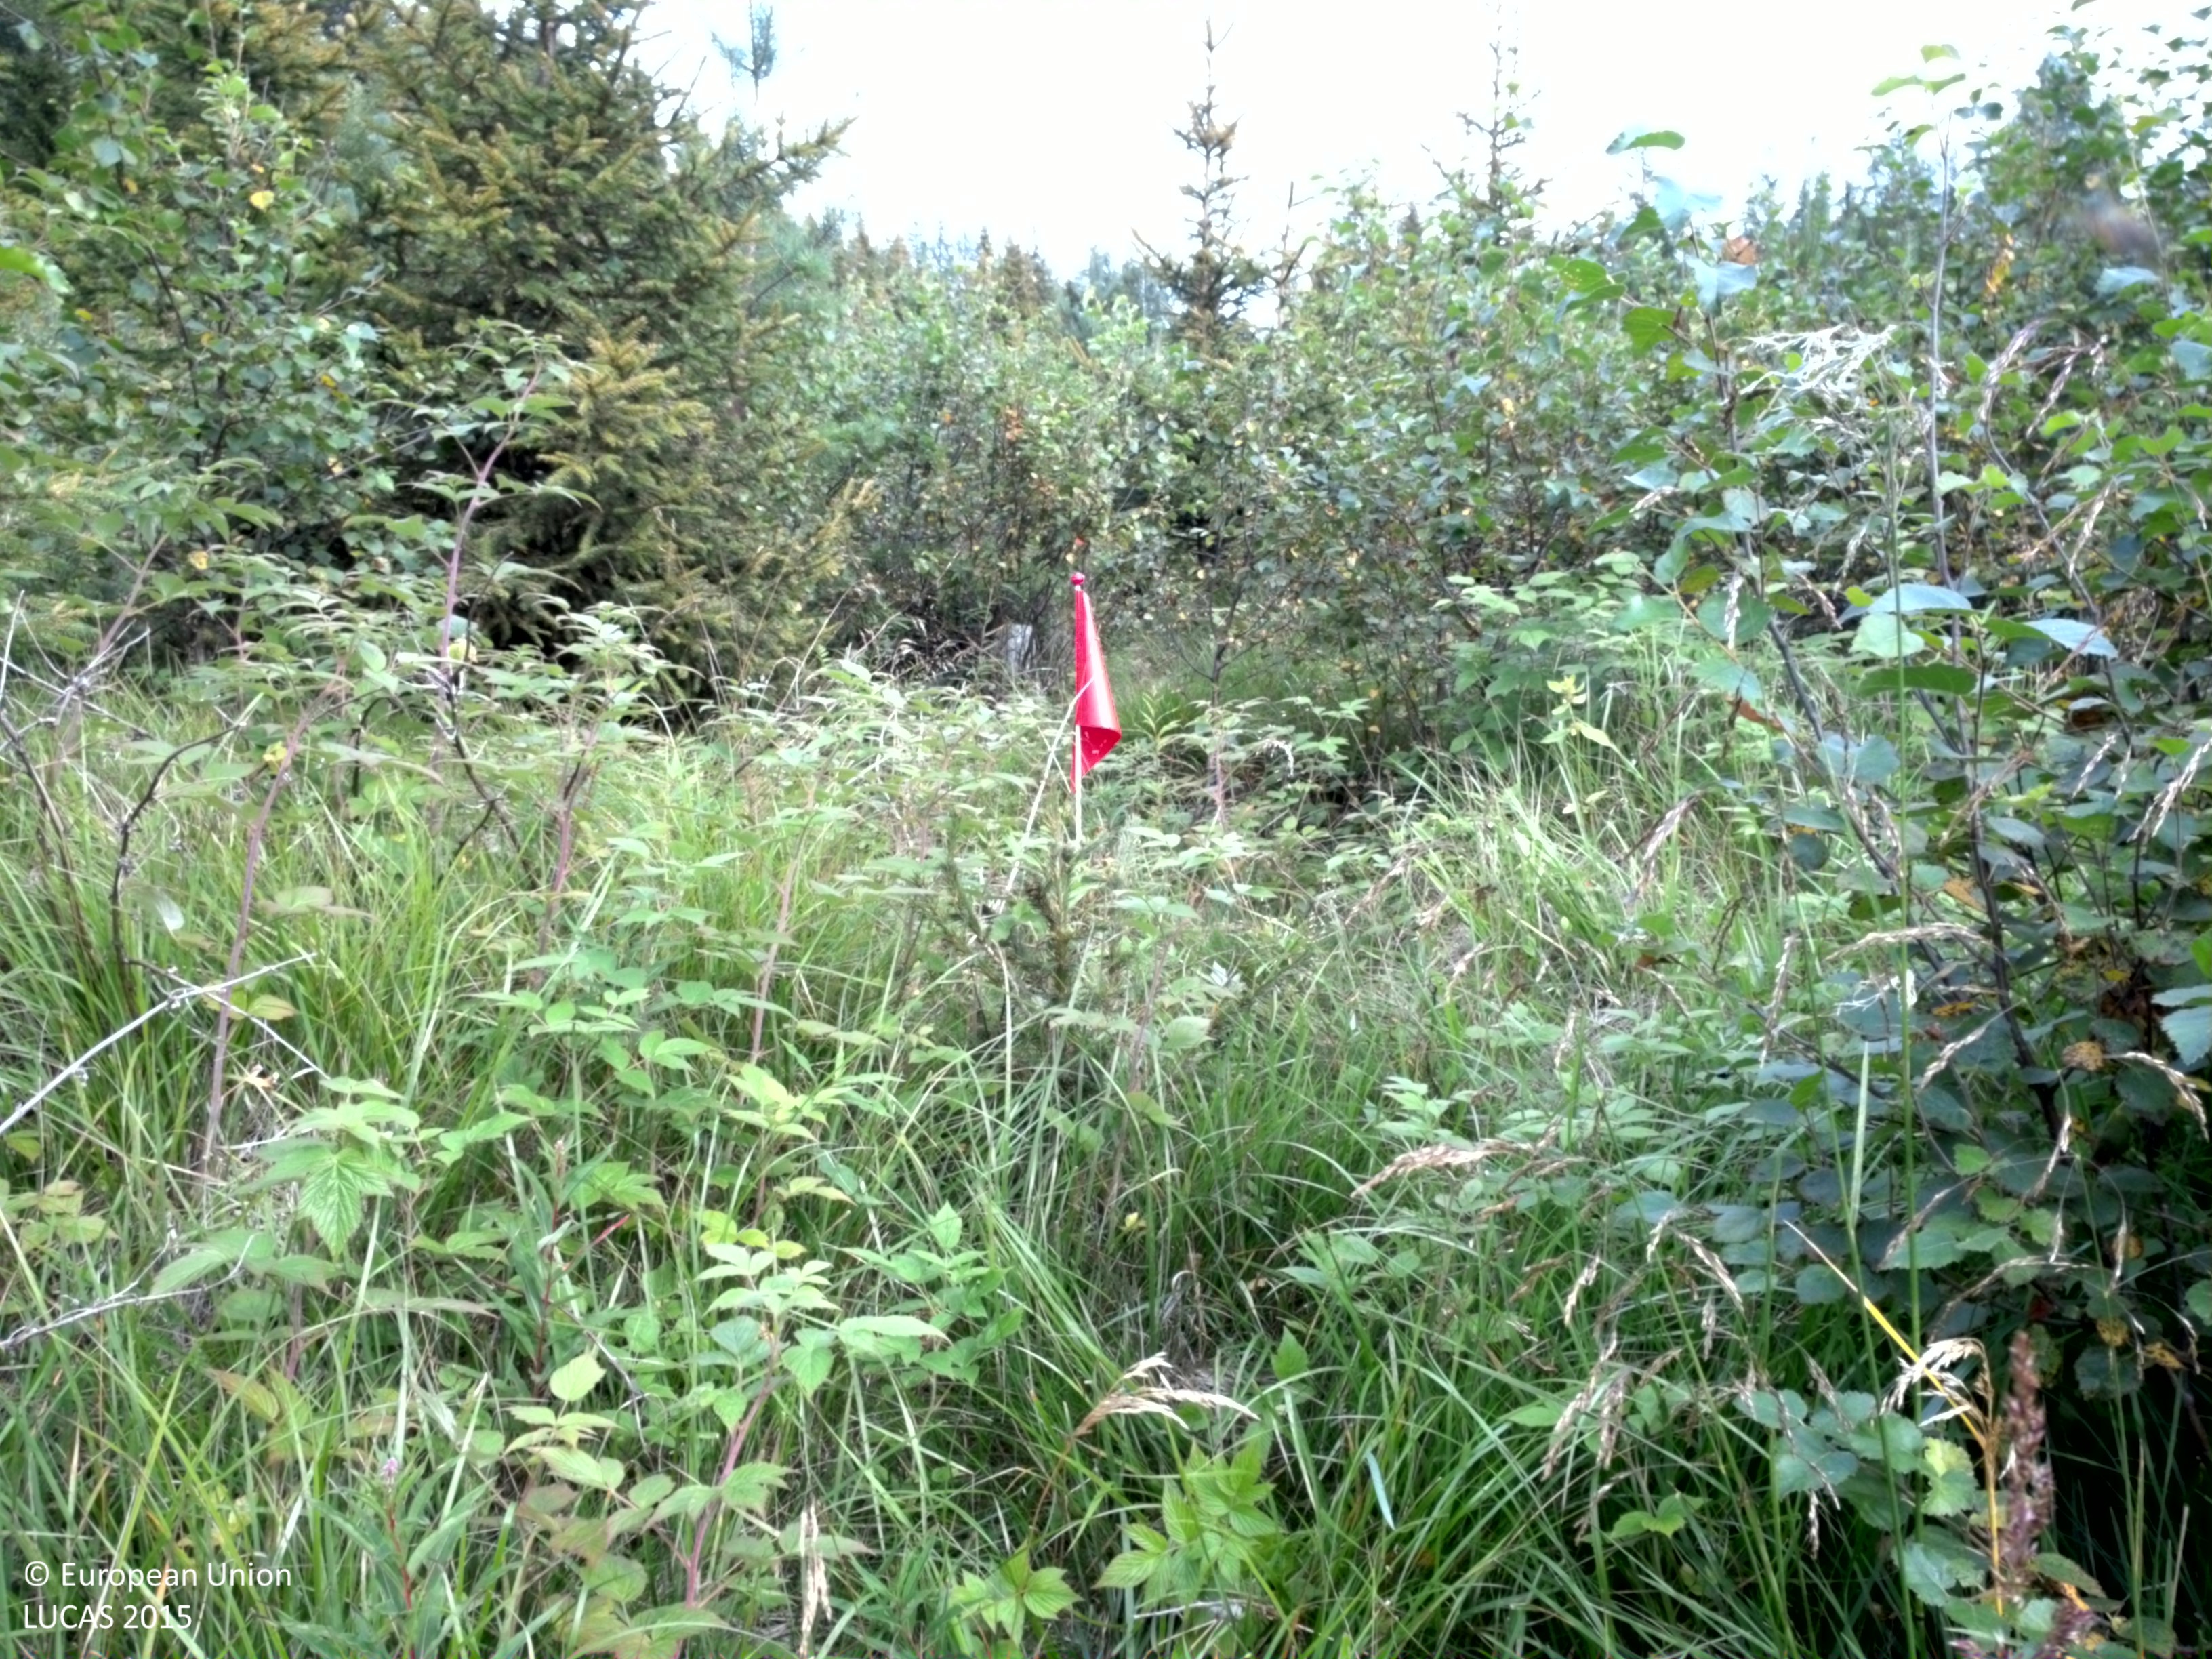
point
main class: Woodland
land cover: Other mixed woodland
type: boreal forest
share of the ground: 50 - 75 %
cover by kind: broadleaved forest trees 35 %, shrubs 35 %, coniferous forest trees 15 %, herbaceous plants 15 %
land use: Forestry
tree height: < 5 m
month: August
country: SE
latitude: 65.9830
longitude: 22.6408
